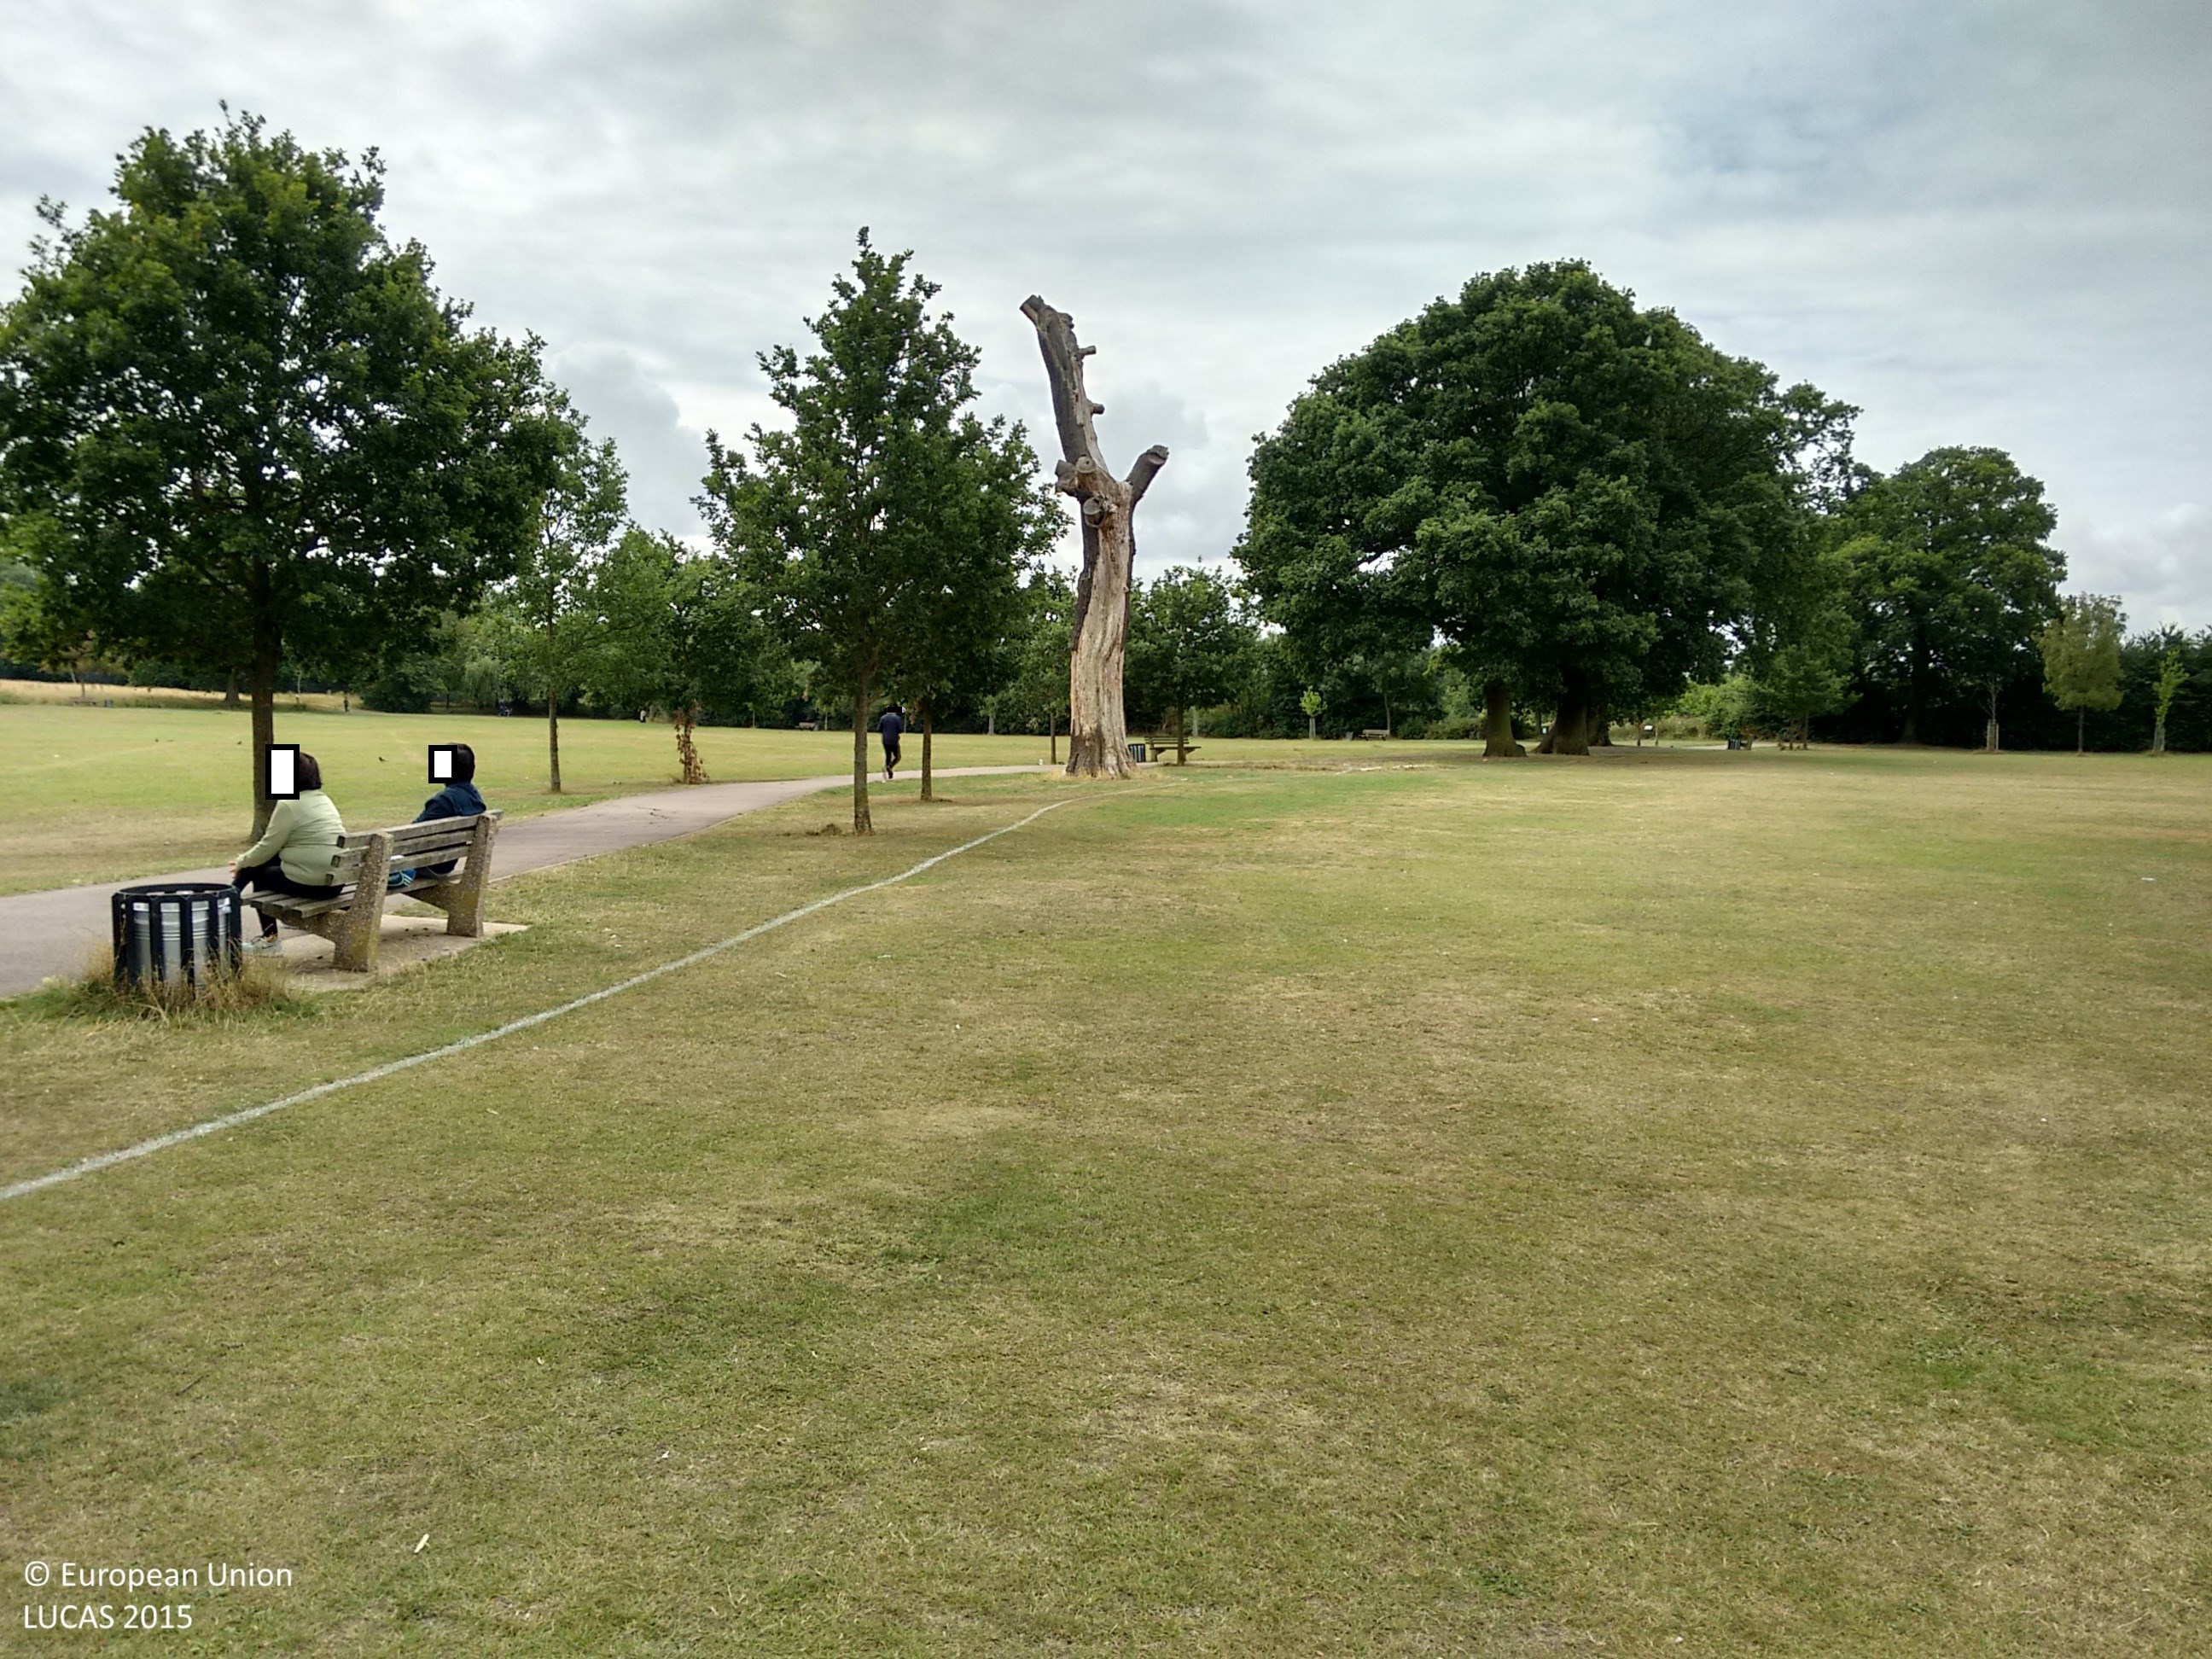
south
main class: Grassland
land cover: Grassland without tree/shrub cover
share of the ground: > 75 %
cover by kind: herbaceous plants 100 %
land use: Amenities, museums, leisure
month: July
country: GB
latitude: 51.5612
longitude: -0.3505
